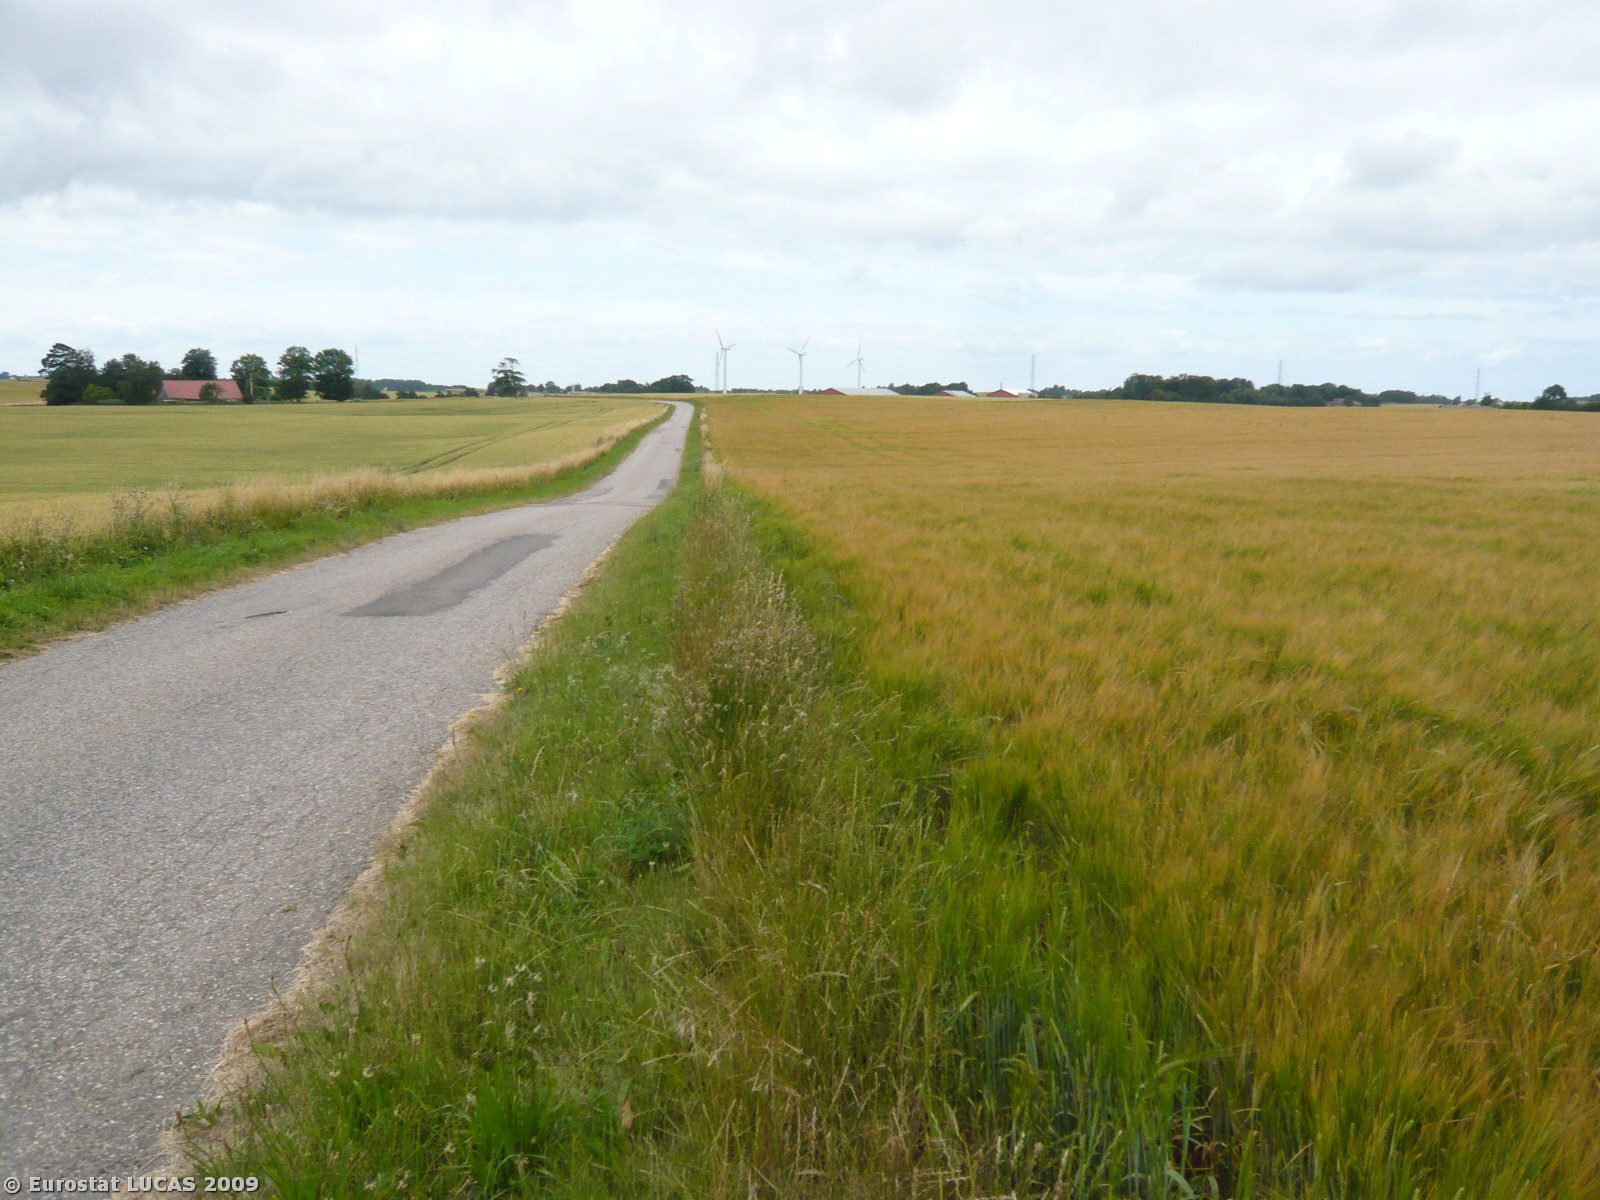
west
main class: Cropland
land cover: Barley
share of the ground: > 75 %
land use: Agriculture (excluding fallow land and kitchen gardens)
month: July
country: DK
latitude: 55.6067
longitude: 11.2211
